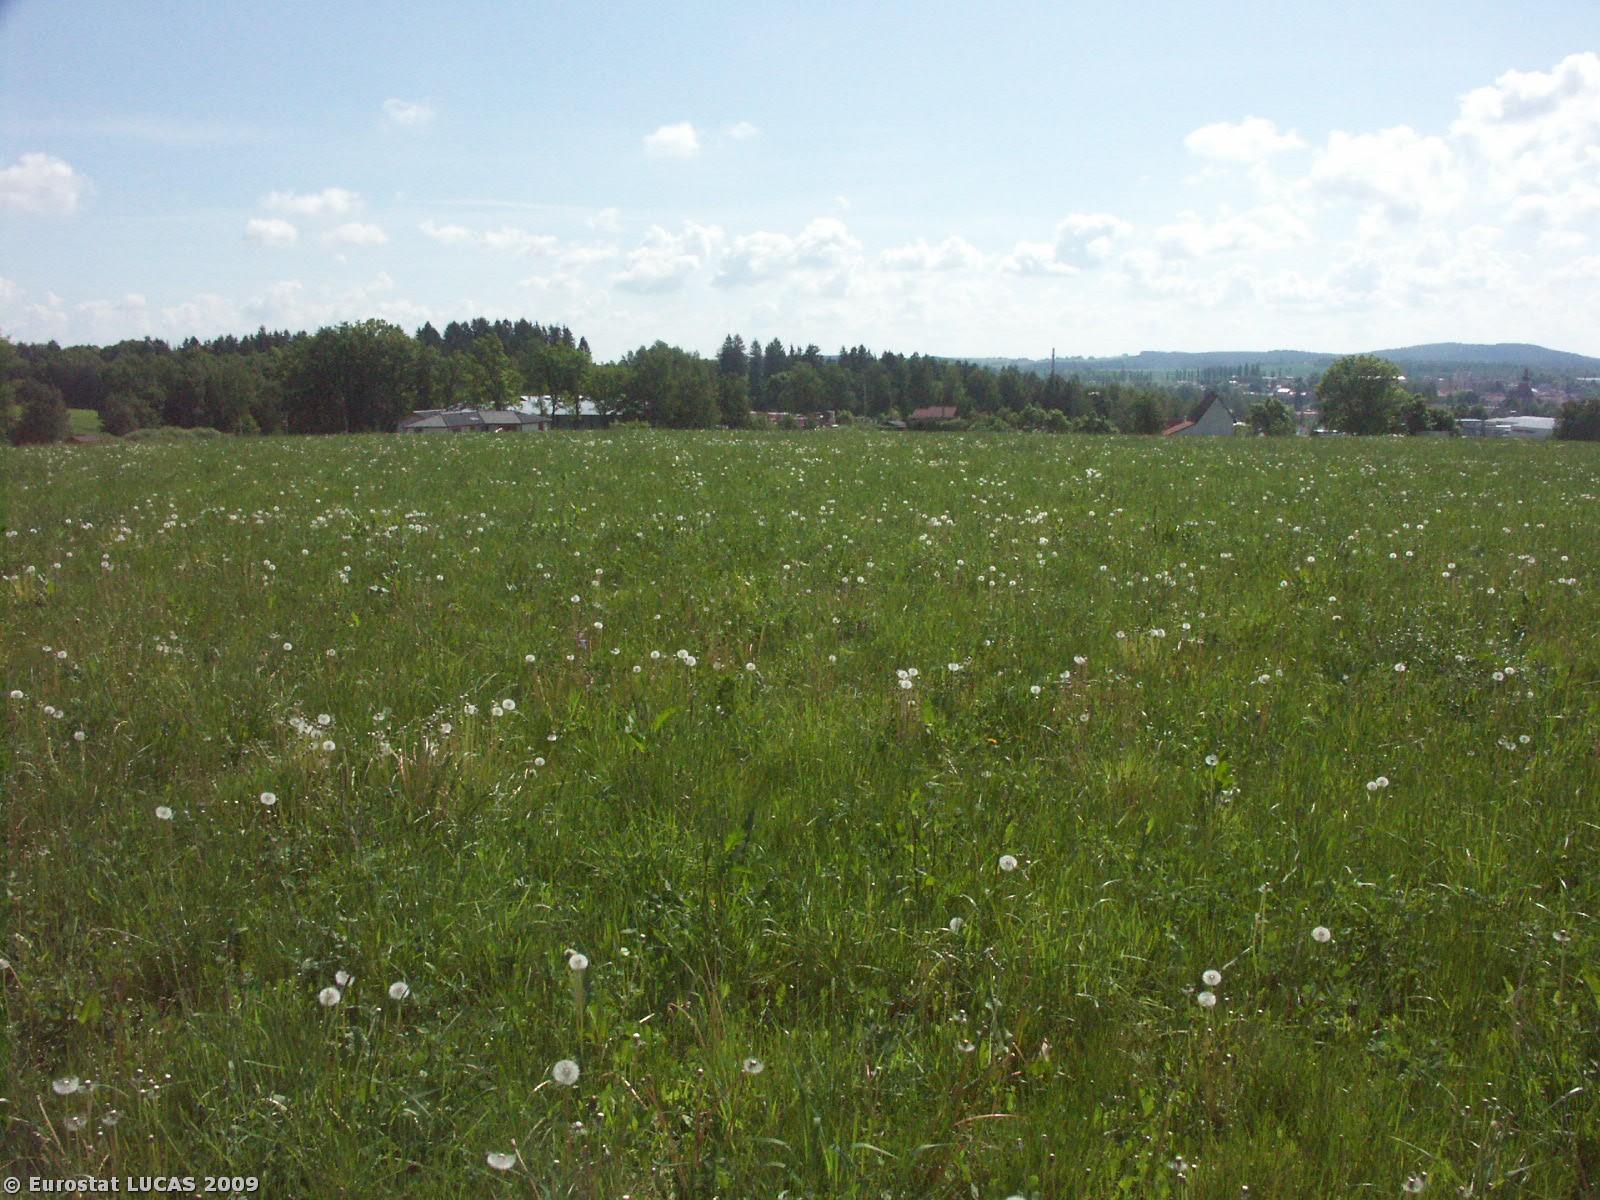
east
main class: Grassland
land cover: Grassland without tree/shrub cover
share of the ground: > 75 %
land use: Agriculture (excluding fallow land and kitchen gardens)
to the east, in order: Grassland without tree/shrub cover; Fences; Apple fruit; Grassland with sparse tree/shrub cover; Fences; Tracks; Grassland without tree/shrub cover; Ditches and canals; Tracks; Grassland without tree/shrub cover; Tracks; Grassland without tree/shrub cover
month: May
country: CZ
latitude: 48.8476
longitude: 14.6209
